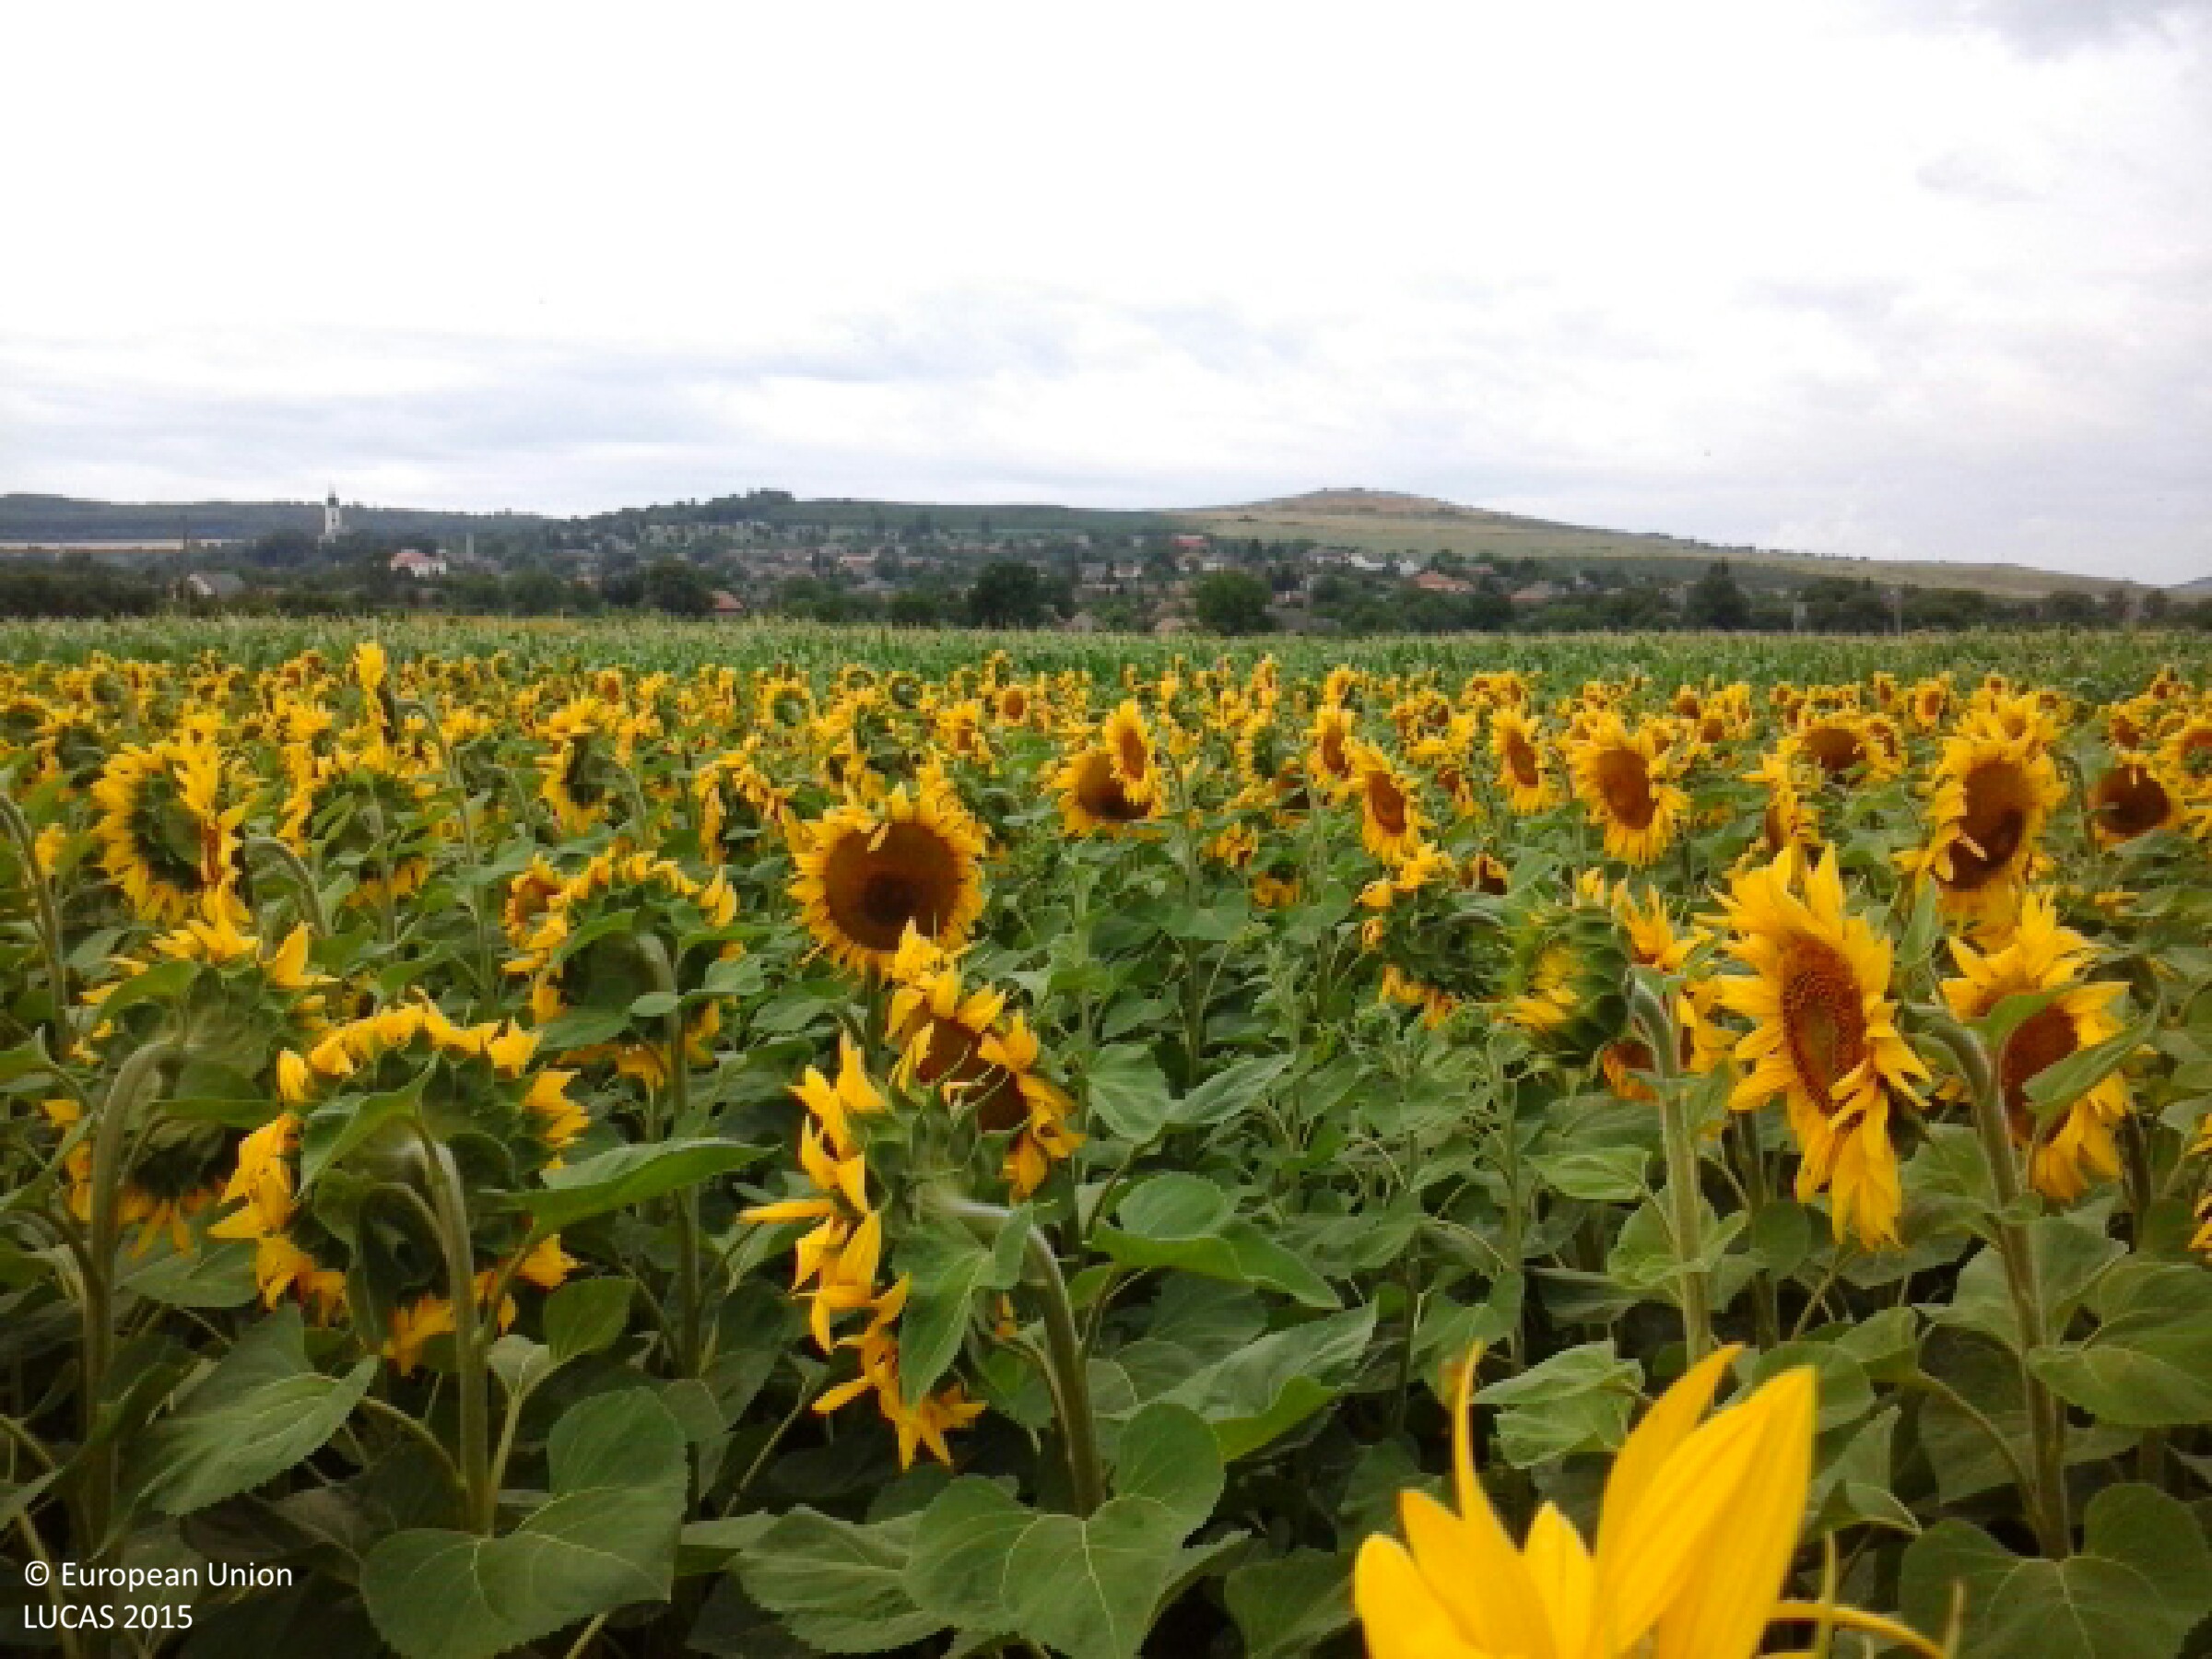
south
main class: Cropland
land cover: Sunflower
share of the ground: > 75 %
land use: Agriculture (excluding fallow land and kitchen gardens)
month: July
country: HU
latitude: 48.2195
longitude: 21.1457
